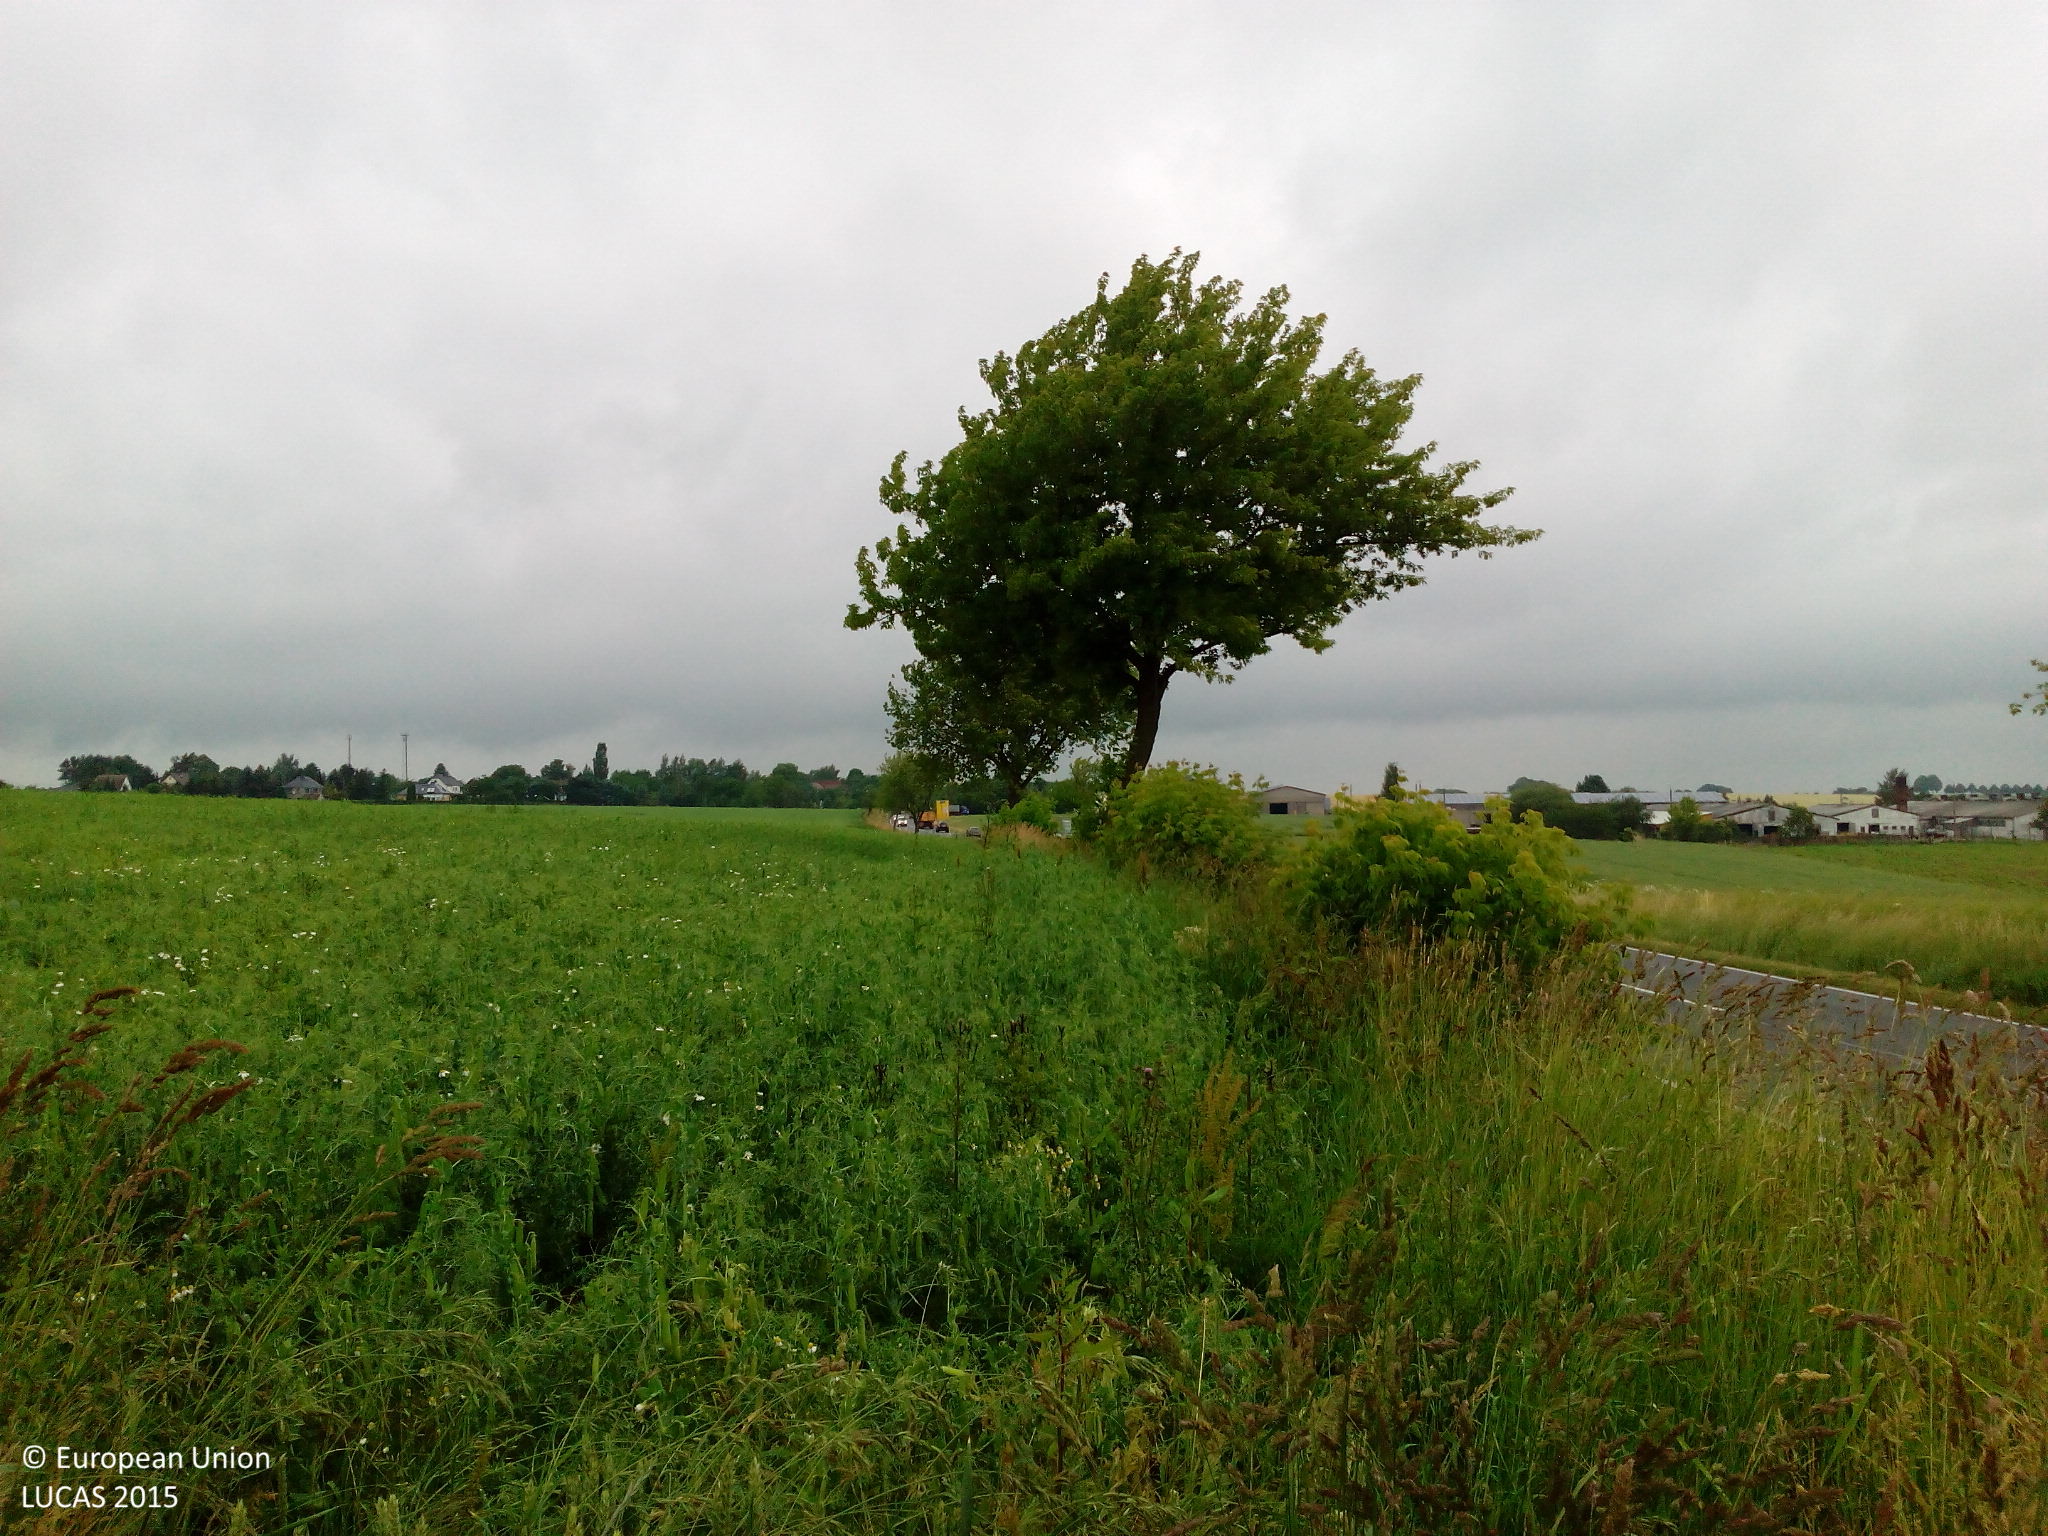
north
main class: Cropland
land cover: Common wheat
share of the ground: > 75 %
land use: Agriculture (excluding fallow land and kitchen gardens)
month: June
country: DE
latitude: 51.0958
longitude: 13.0987
